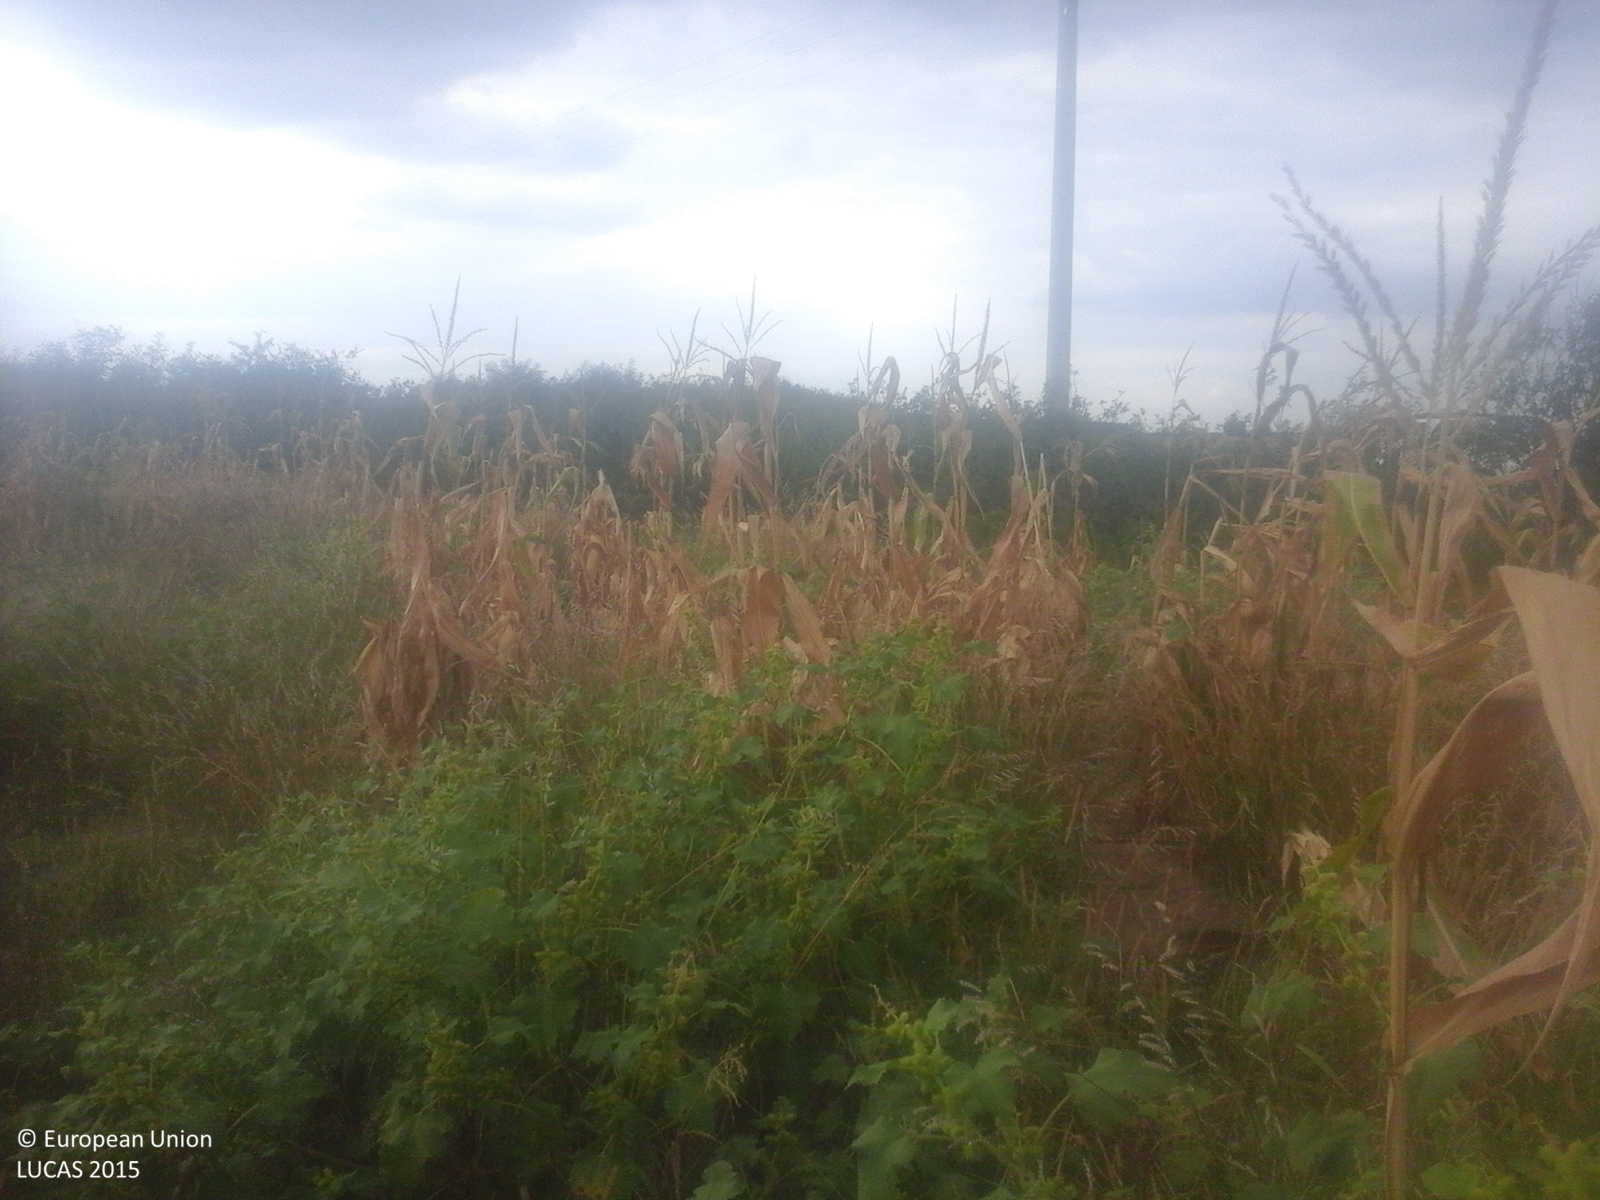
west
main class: Cropland
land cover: Maize
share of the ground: > 75 %
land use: Agriculture (excluding fallow land and kitchen gardens)
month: September
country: RO
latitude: 47.7115
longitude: 22.7916
